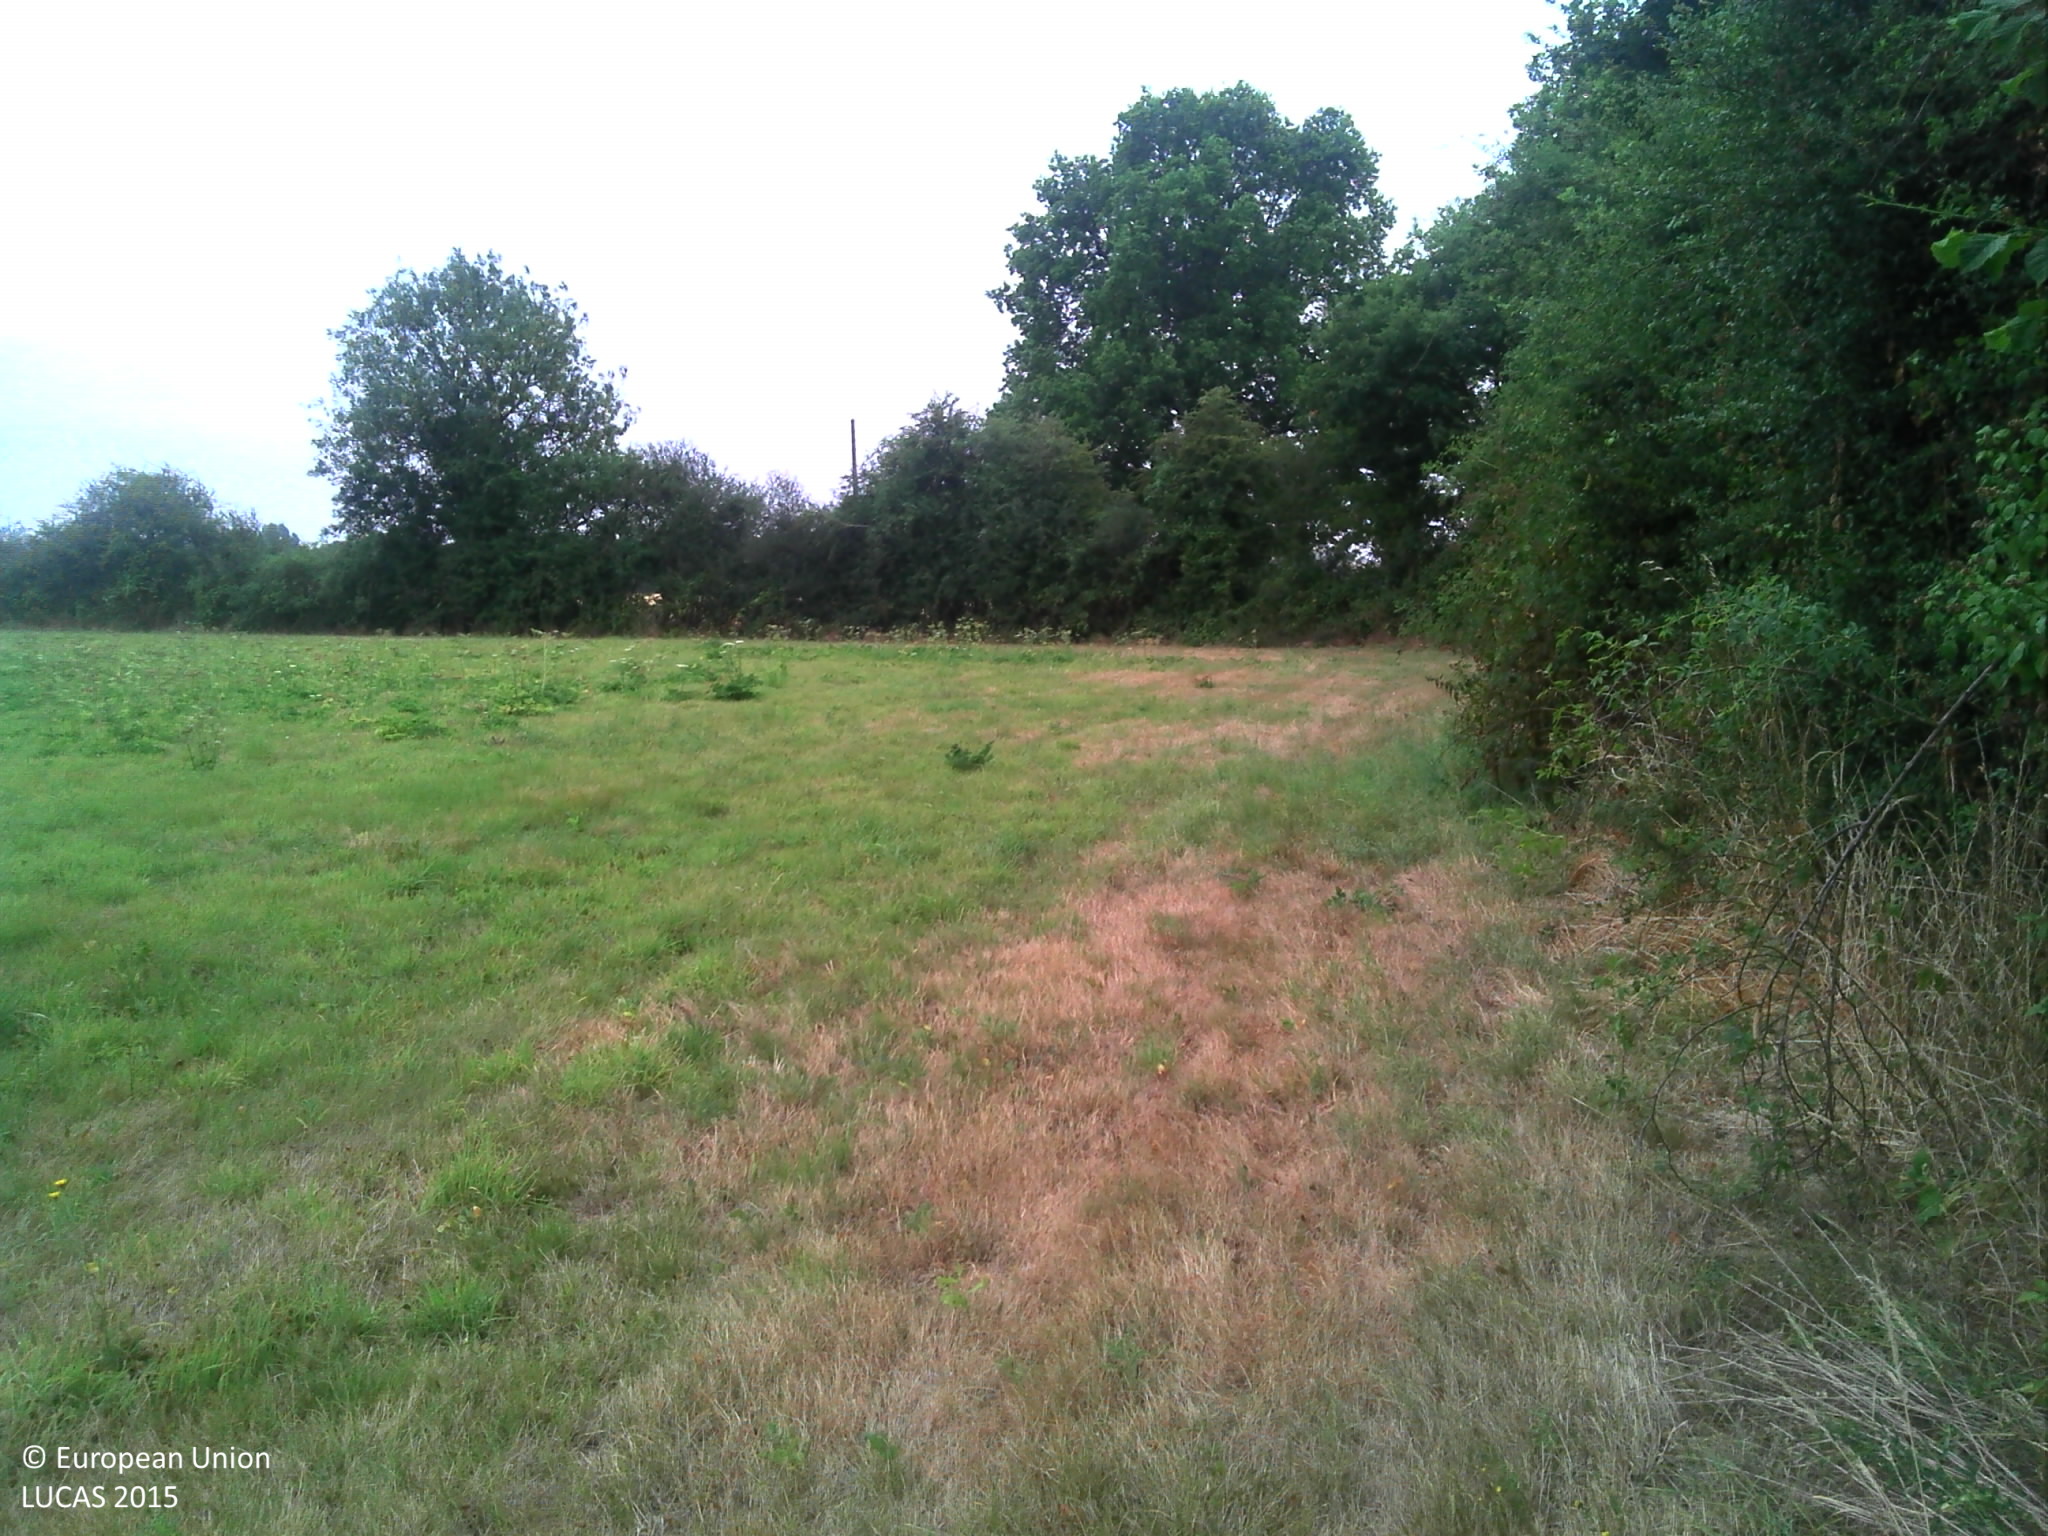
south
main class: Grassland
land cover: Grassland without tree/shrub cover
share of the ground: > 75 %
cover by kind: herbaceous plants 100 %
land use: Agriculture (excluding fallow land and kitchen gardens)
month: July
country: FR
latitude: 48.2215
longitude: 1.0565
